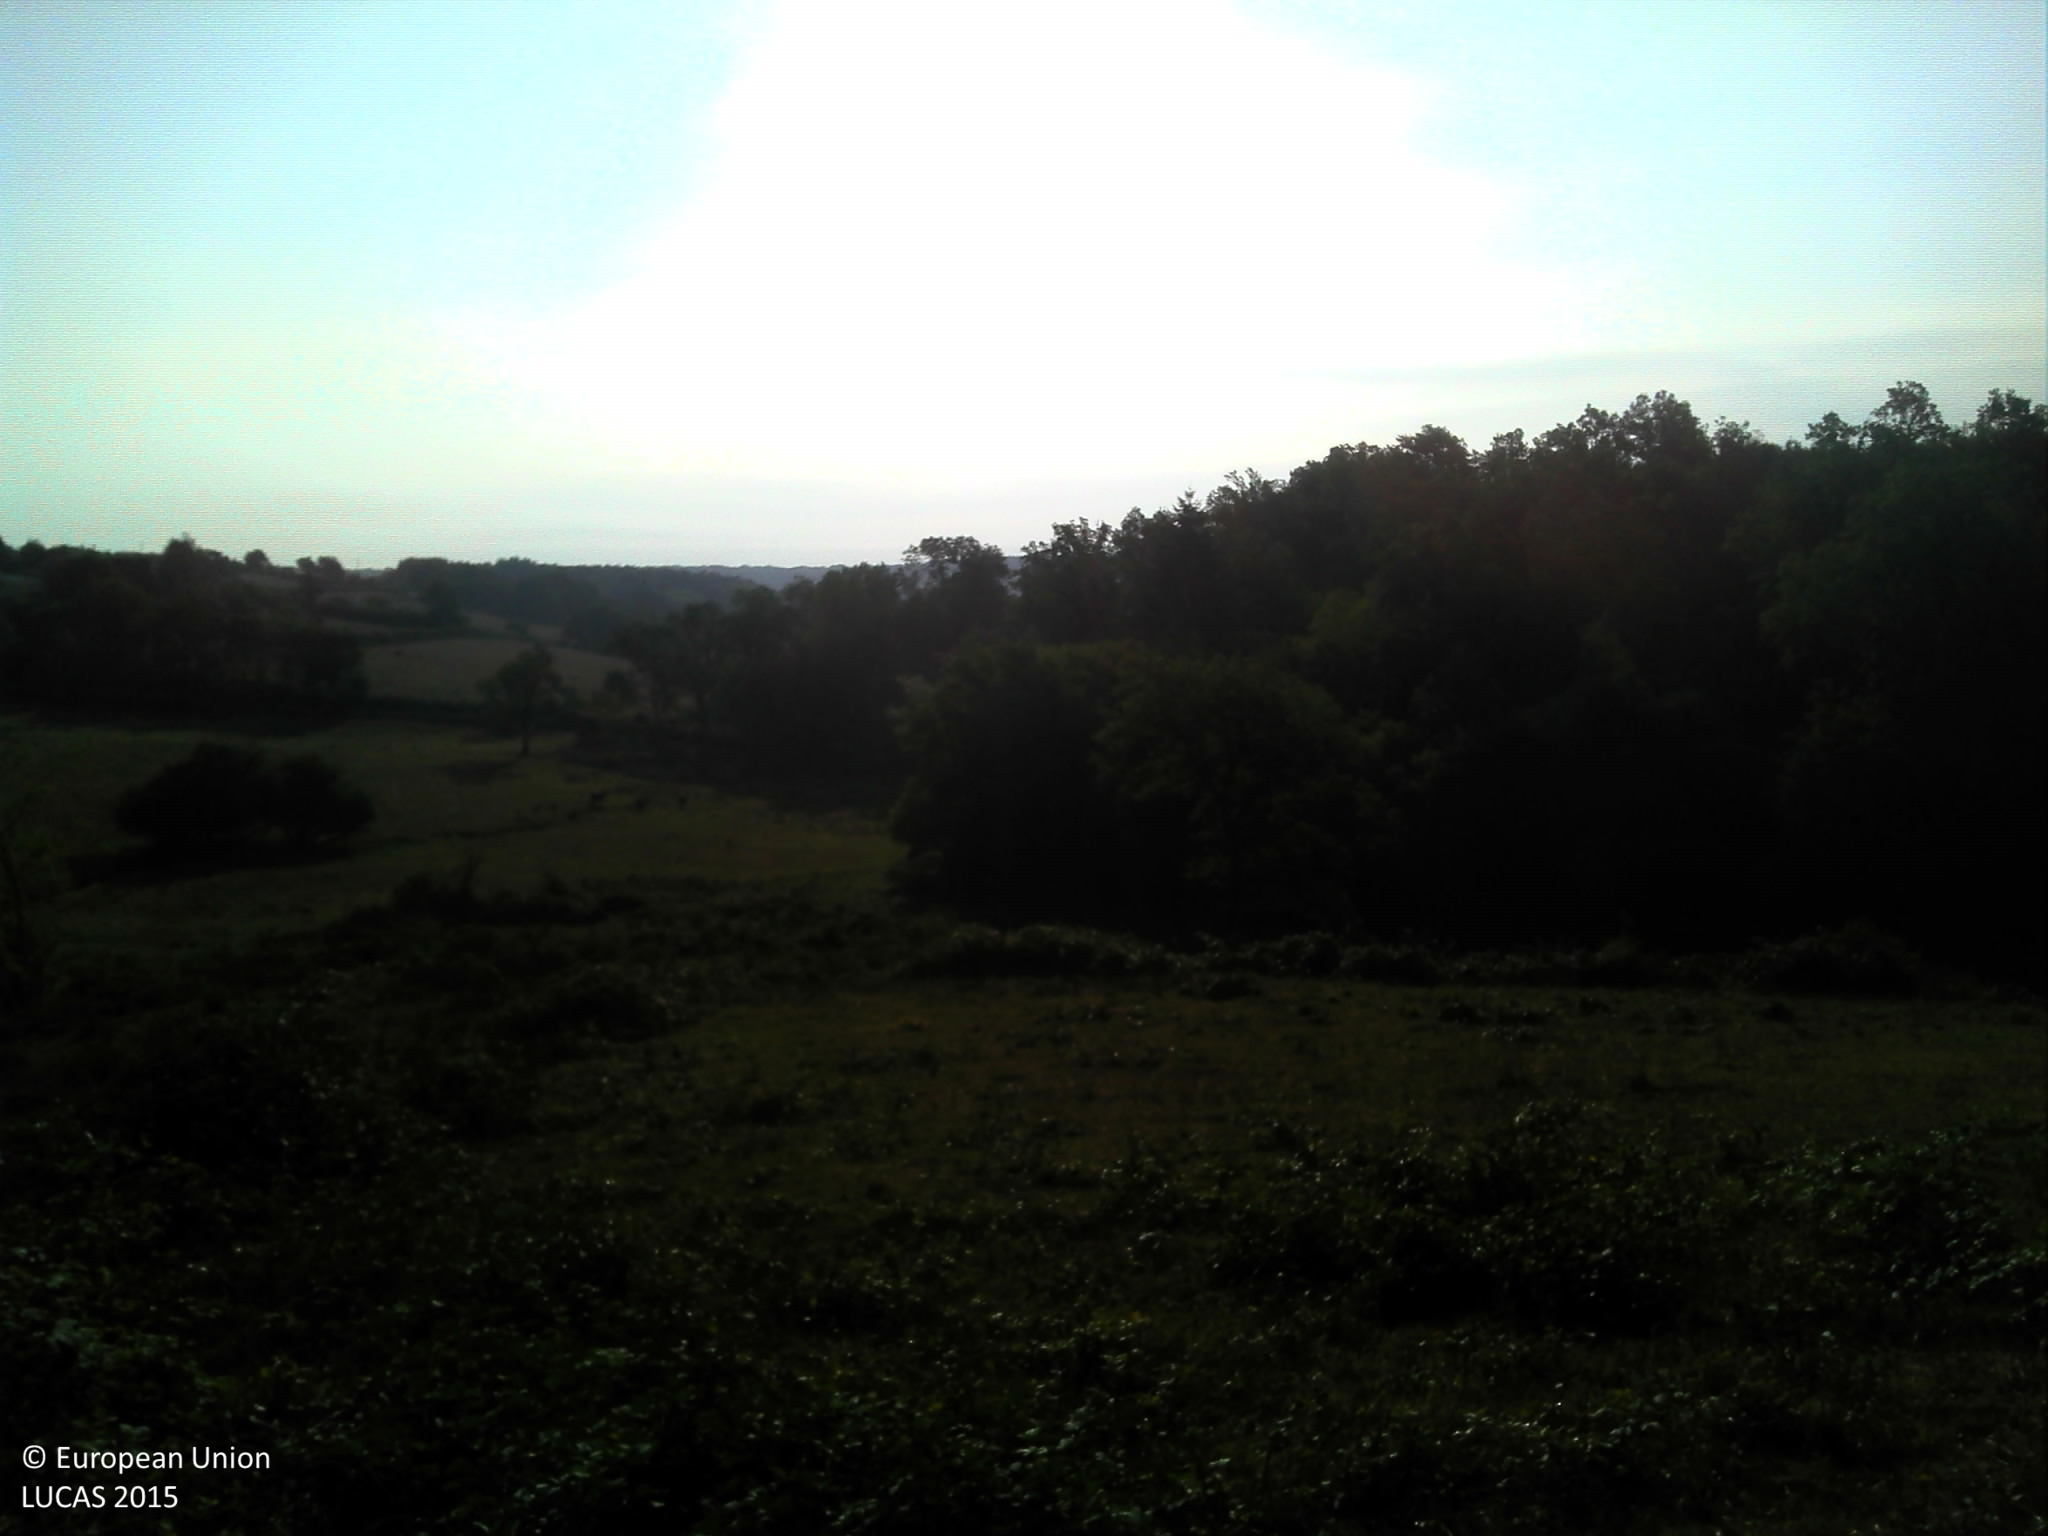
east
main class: Shrubland
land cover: Shrubland without tree cover
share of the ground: > 75 %
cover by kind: shrubs 50 %, herbaceous plants 50 %
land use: Forestry
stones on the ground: < 10 %
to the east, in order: Shrubland without tree cover; Grassland without tree/shrub cover; Fences; Broadleaved woodland
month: August
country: FR
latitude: 47.1028
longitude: 4.3205
